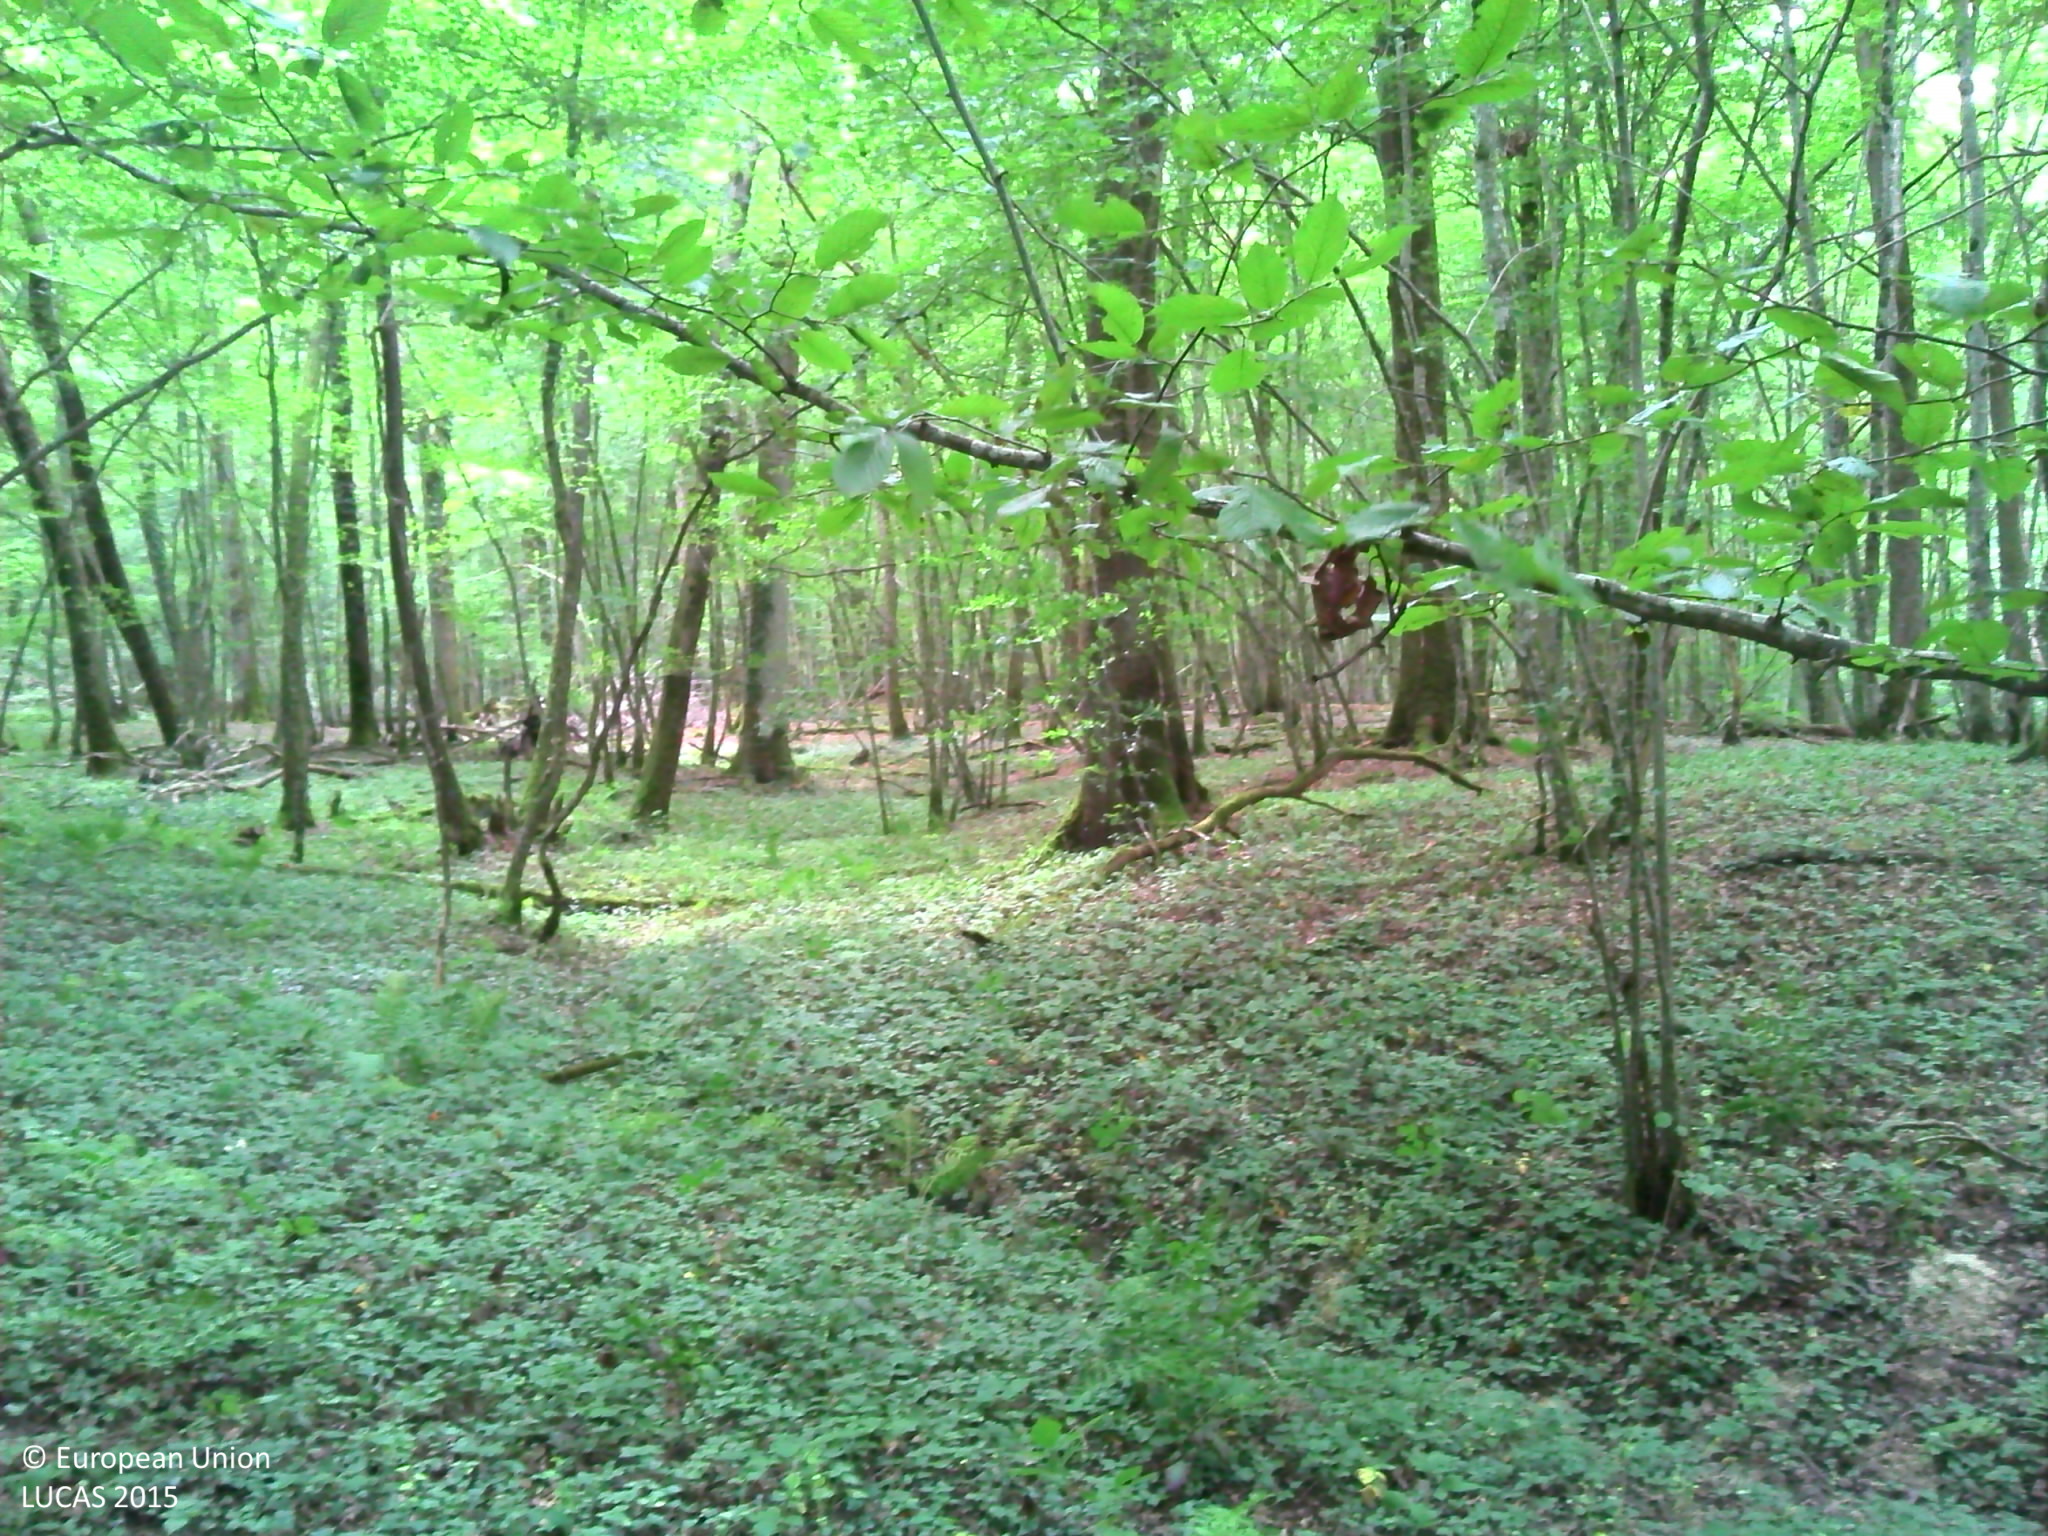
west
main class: Woodland
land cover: Broadleaved woodland
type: mesophytic deciduous forest
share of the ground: > 75 %
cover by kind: broadleaved forest trees 95 %, herbaceous plants 5 %
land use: Forestry
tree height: > 5 m
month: July
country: FR
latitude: 46.5413
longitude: 2.7850
